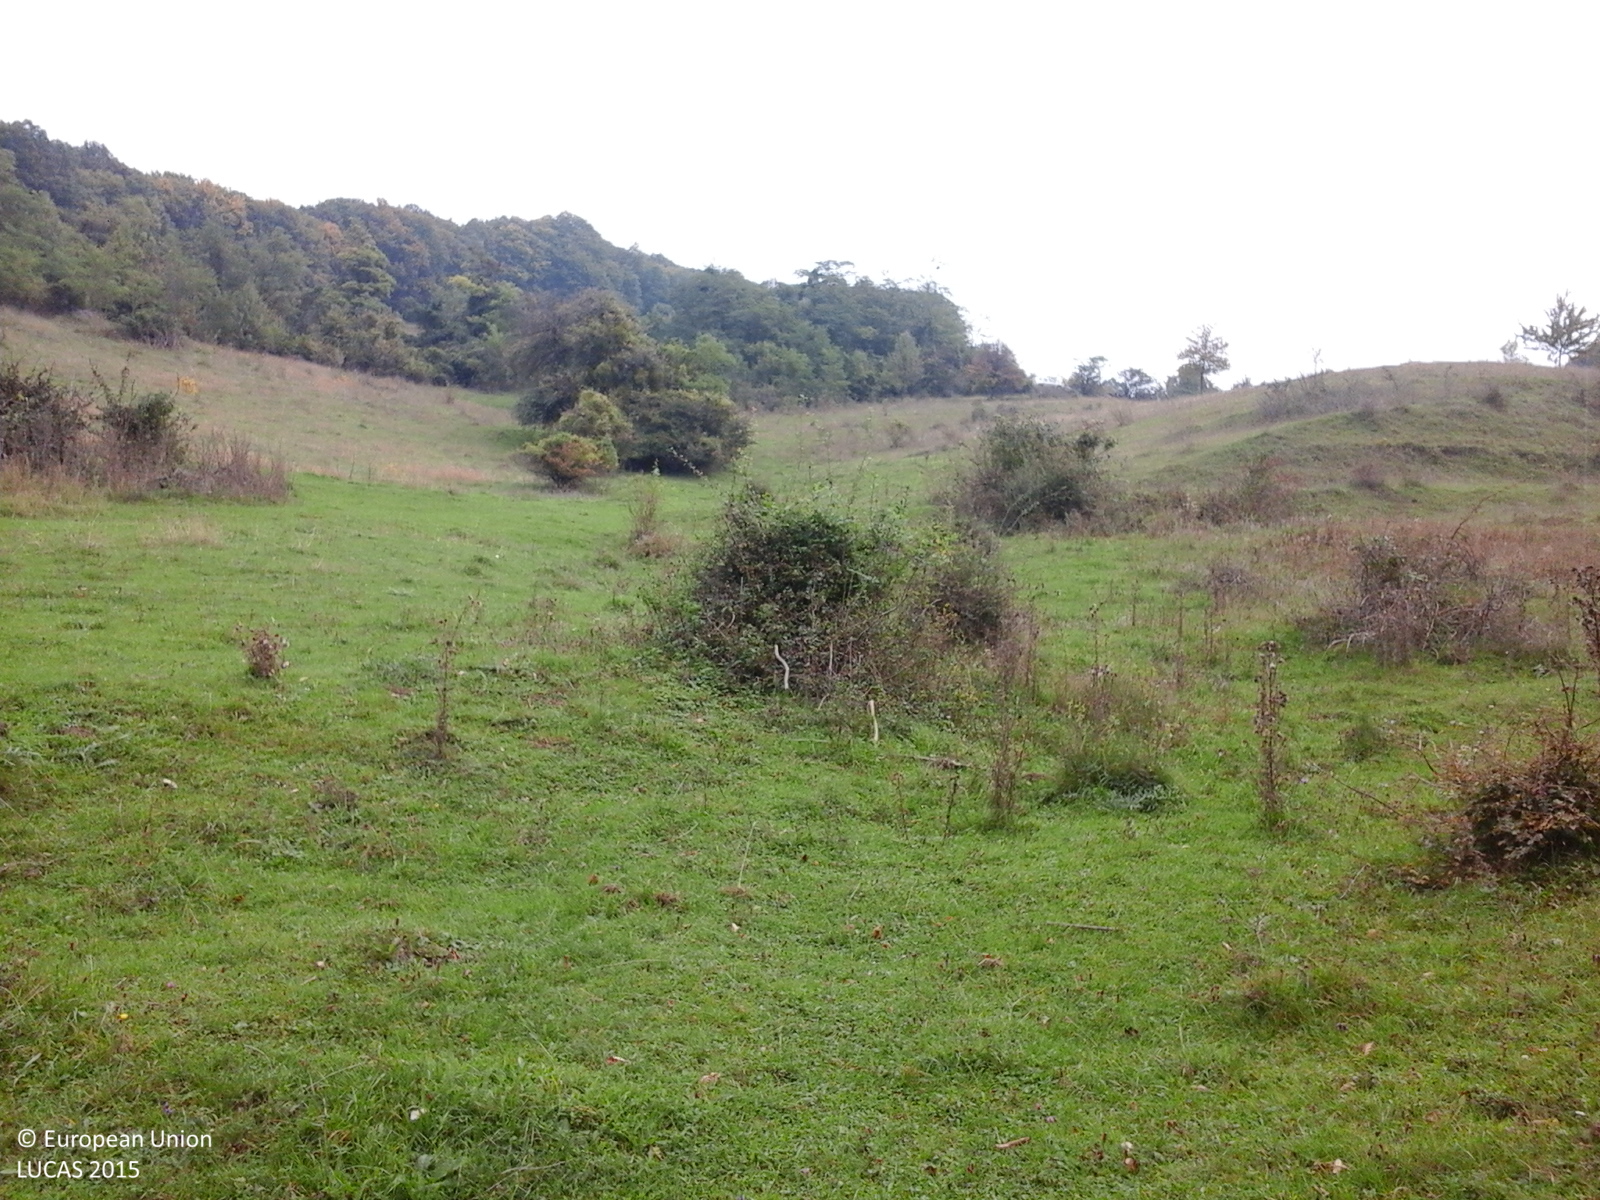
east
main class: Grassland
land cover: Grassland without tree/shrub cover
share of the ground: > 75 %
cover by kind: herbaceous plants 100 %
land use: Agriculture (excluding fallow land and kitchen gardens)
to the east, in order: Grassland without tree/shrub cover; Grassland with sparse tree/shrub cover; Broadleaved woodland; Grassland with sparse tree/shrub cover; Abandoned hedges; Grass margins; Tracks; Grass margins; Ditches and canals; Abandoned hedges; Grassland with sparse tree/shrub cover; Electric lines; Grassland with sparse tree/shrub cover
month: October
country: RO
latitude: 46.3129
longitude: 24.8578
